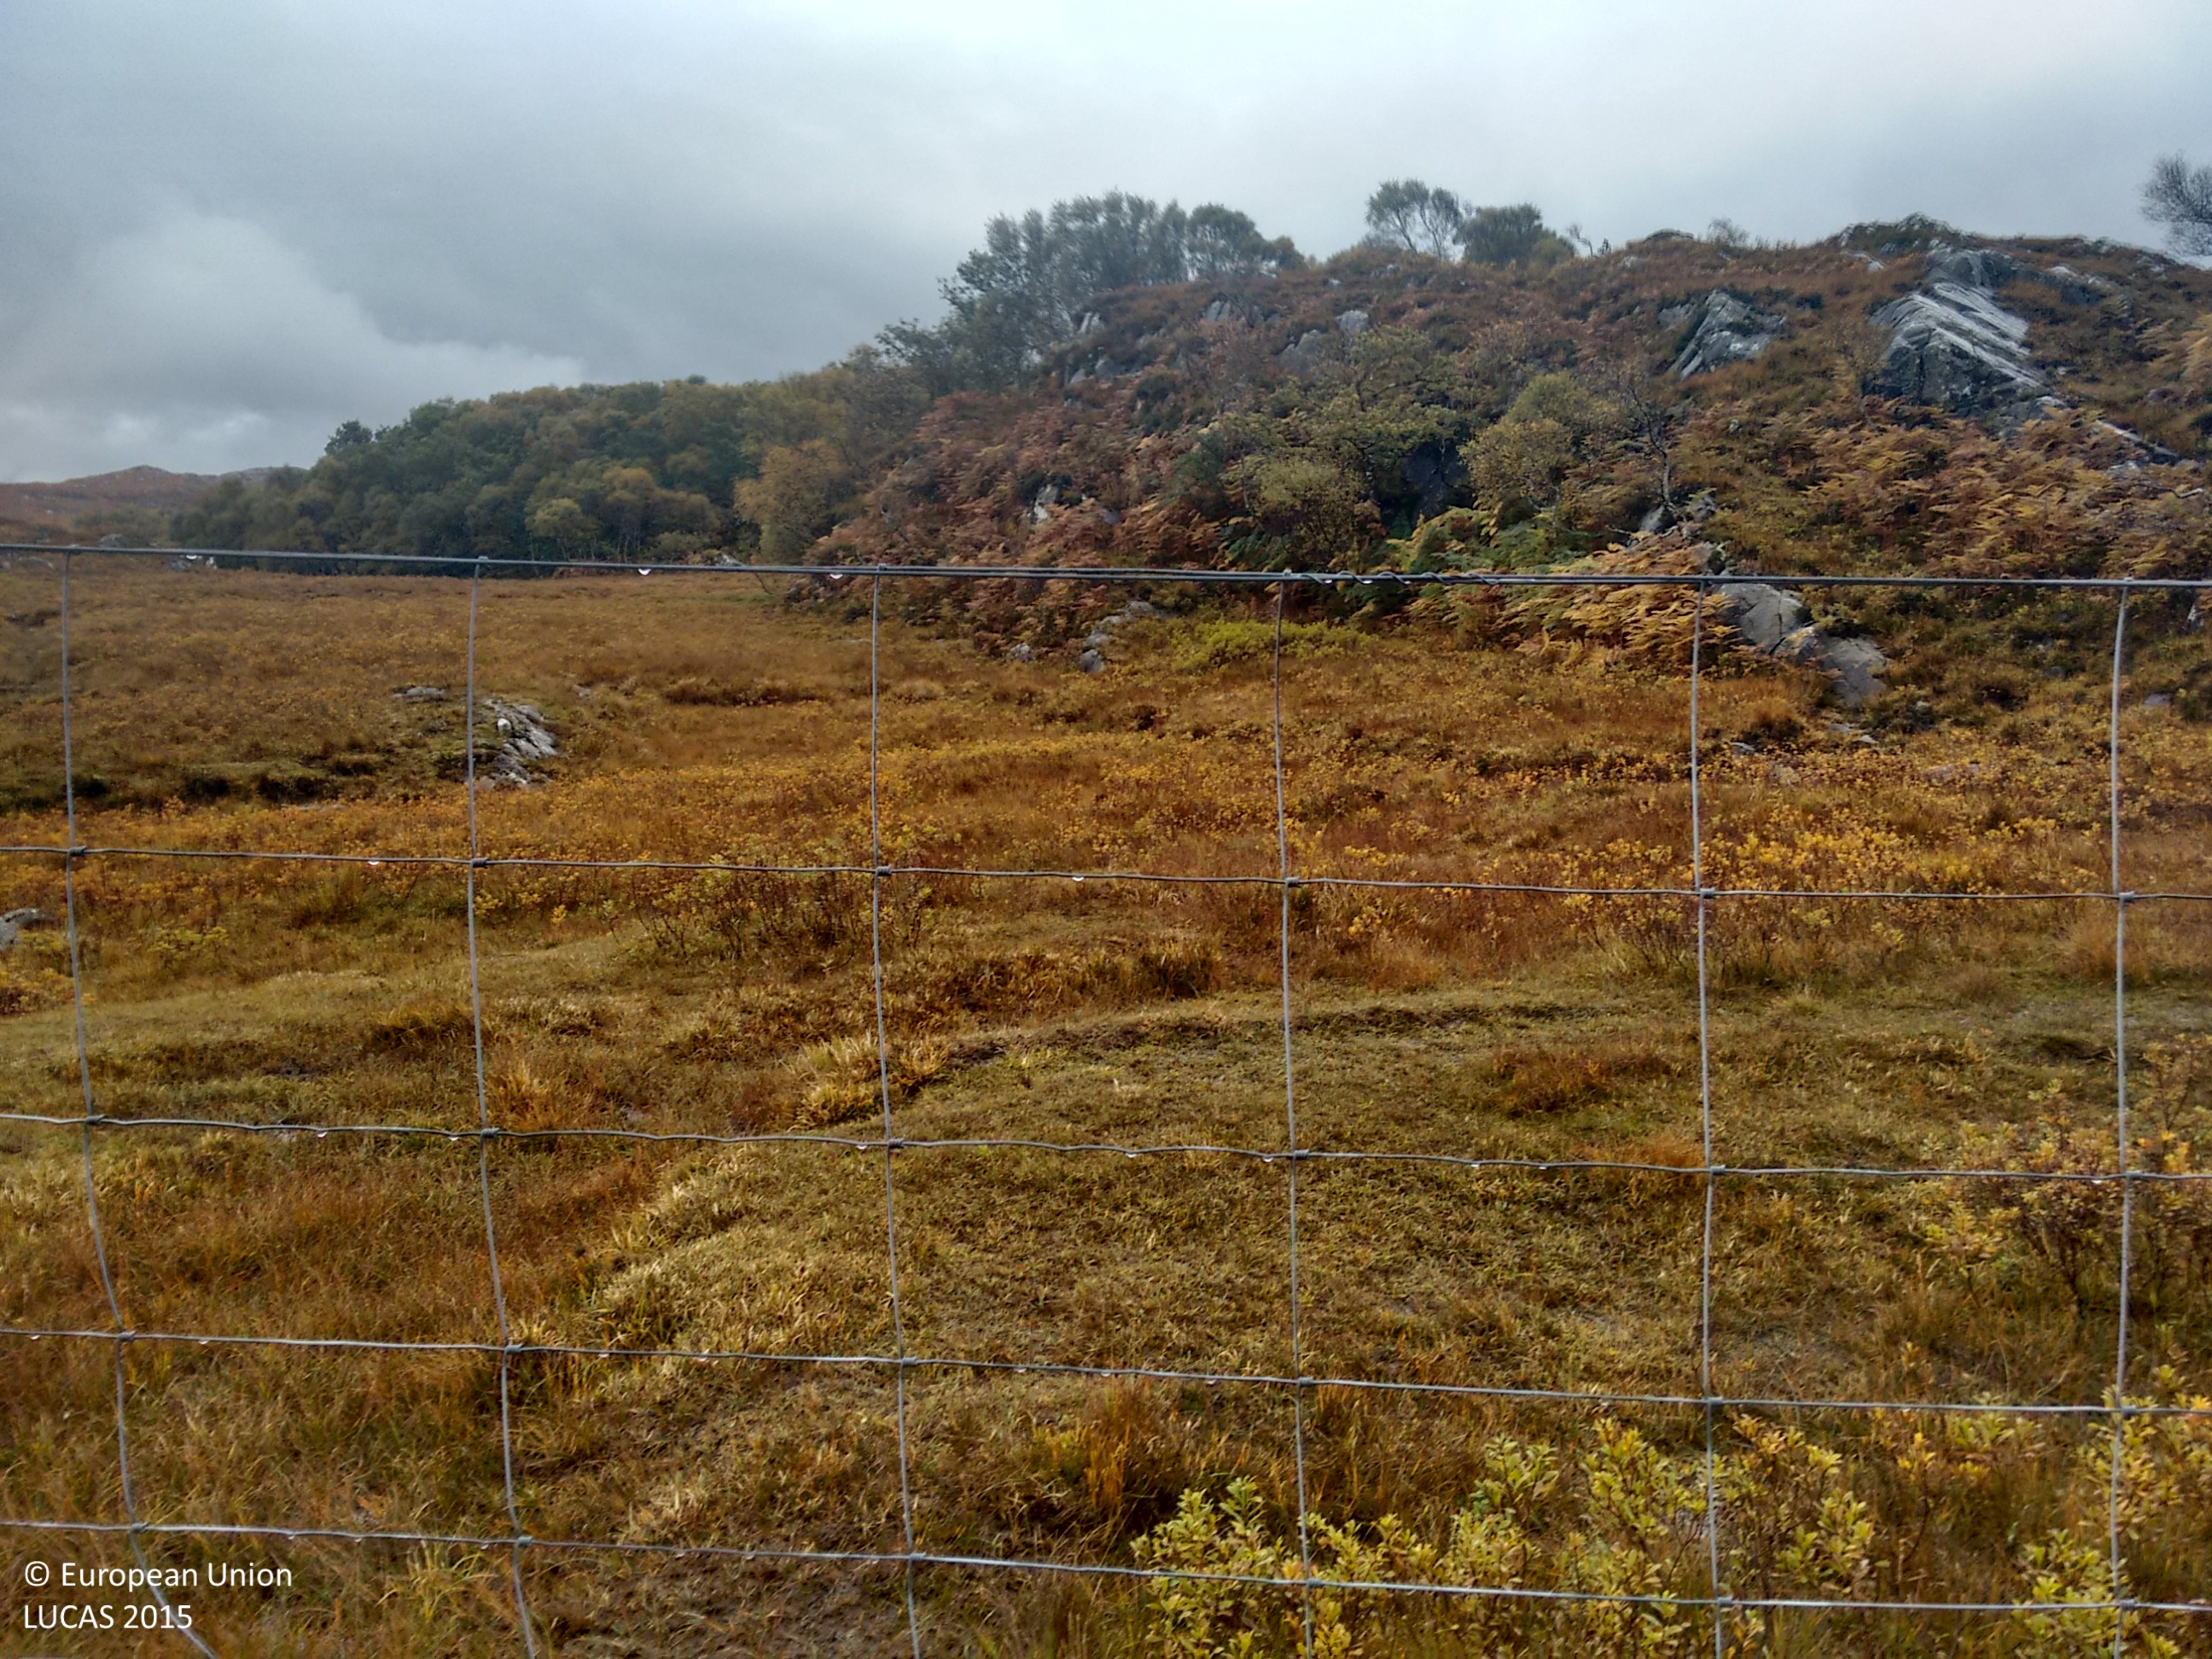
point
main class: Shrubland
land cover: Shrubland without tree cover
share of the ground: > 75 %
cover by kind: shrubs 80 %, herbaceous plants 20 %
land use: Agriculture (excluding fallow land and kitchen gardens)
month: October
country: GB
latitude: 56.7380
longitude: -5.8383
